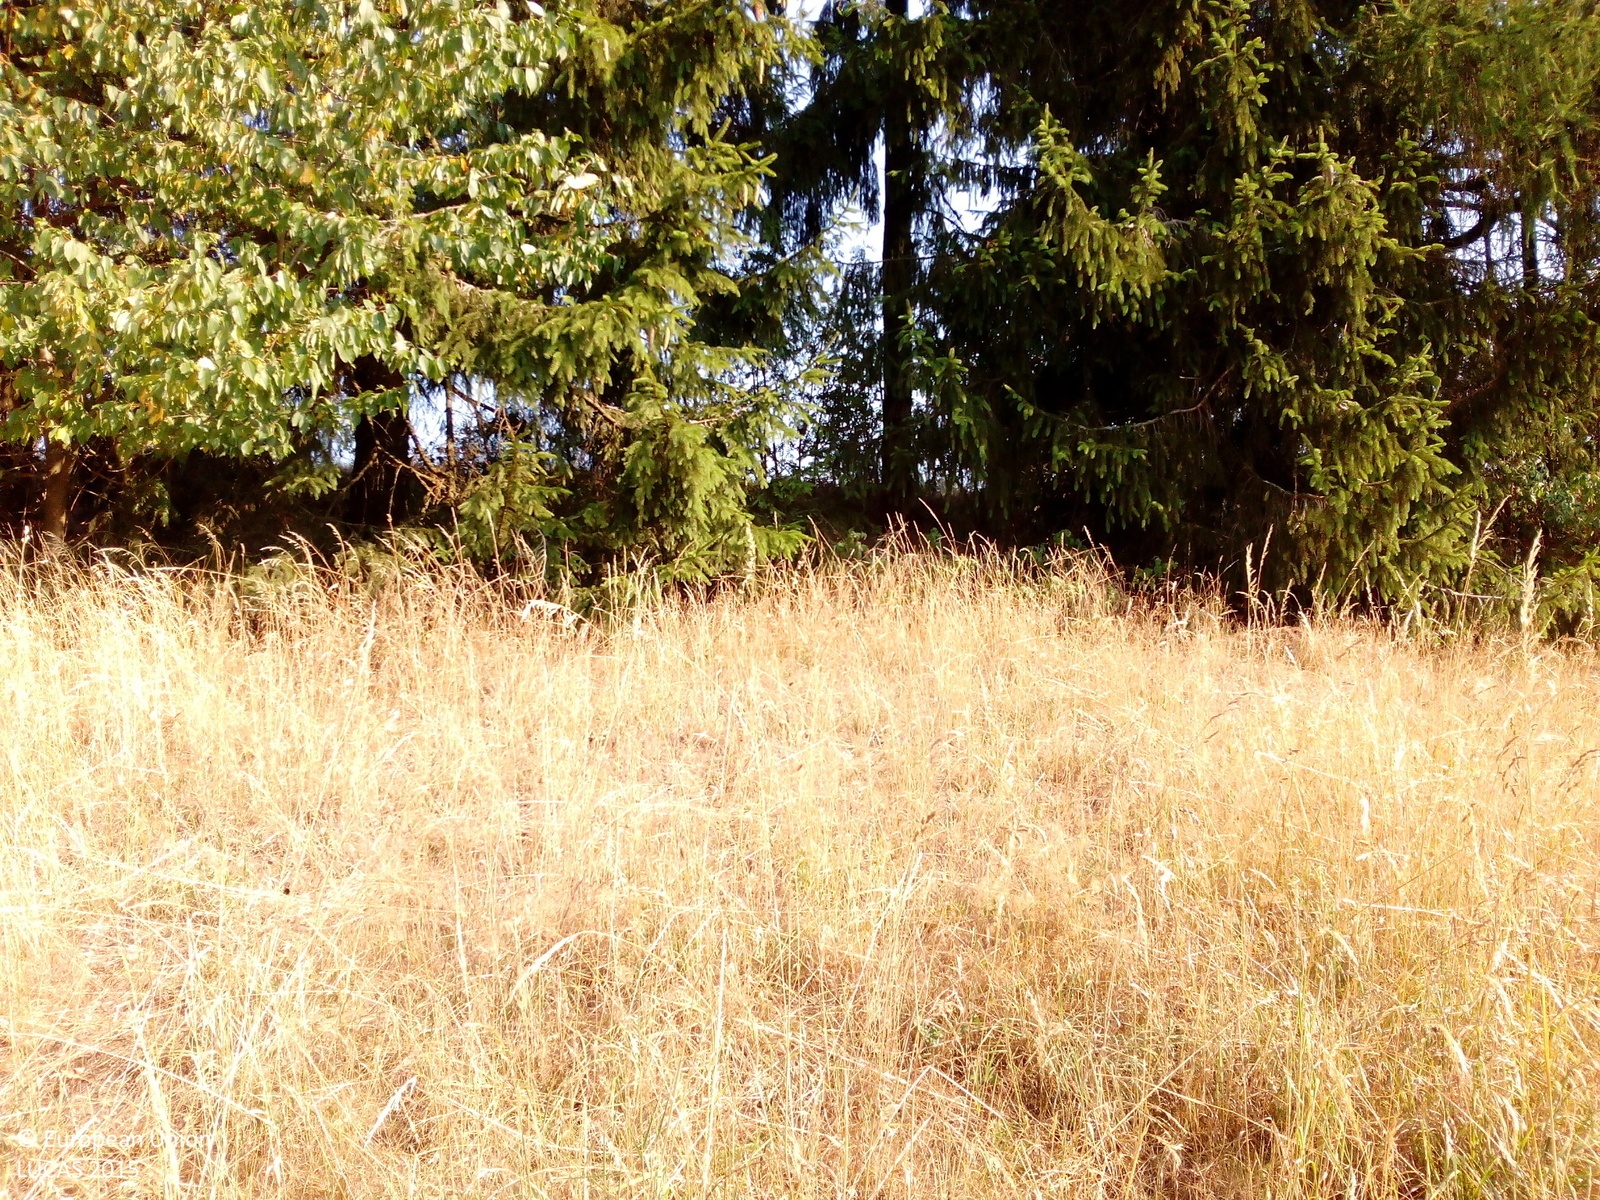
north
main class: Woodland
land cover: Spruce dominated coniferous woodland
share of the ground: > 75 %
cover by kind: coniferous forest trees 80 %, herbaceous plants 20 %
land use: Forestry
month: August
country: DE
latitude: 50.2448
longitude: 11.6122
